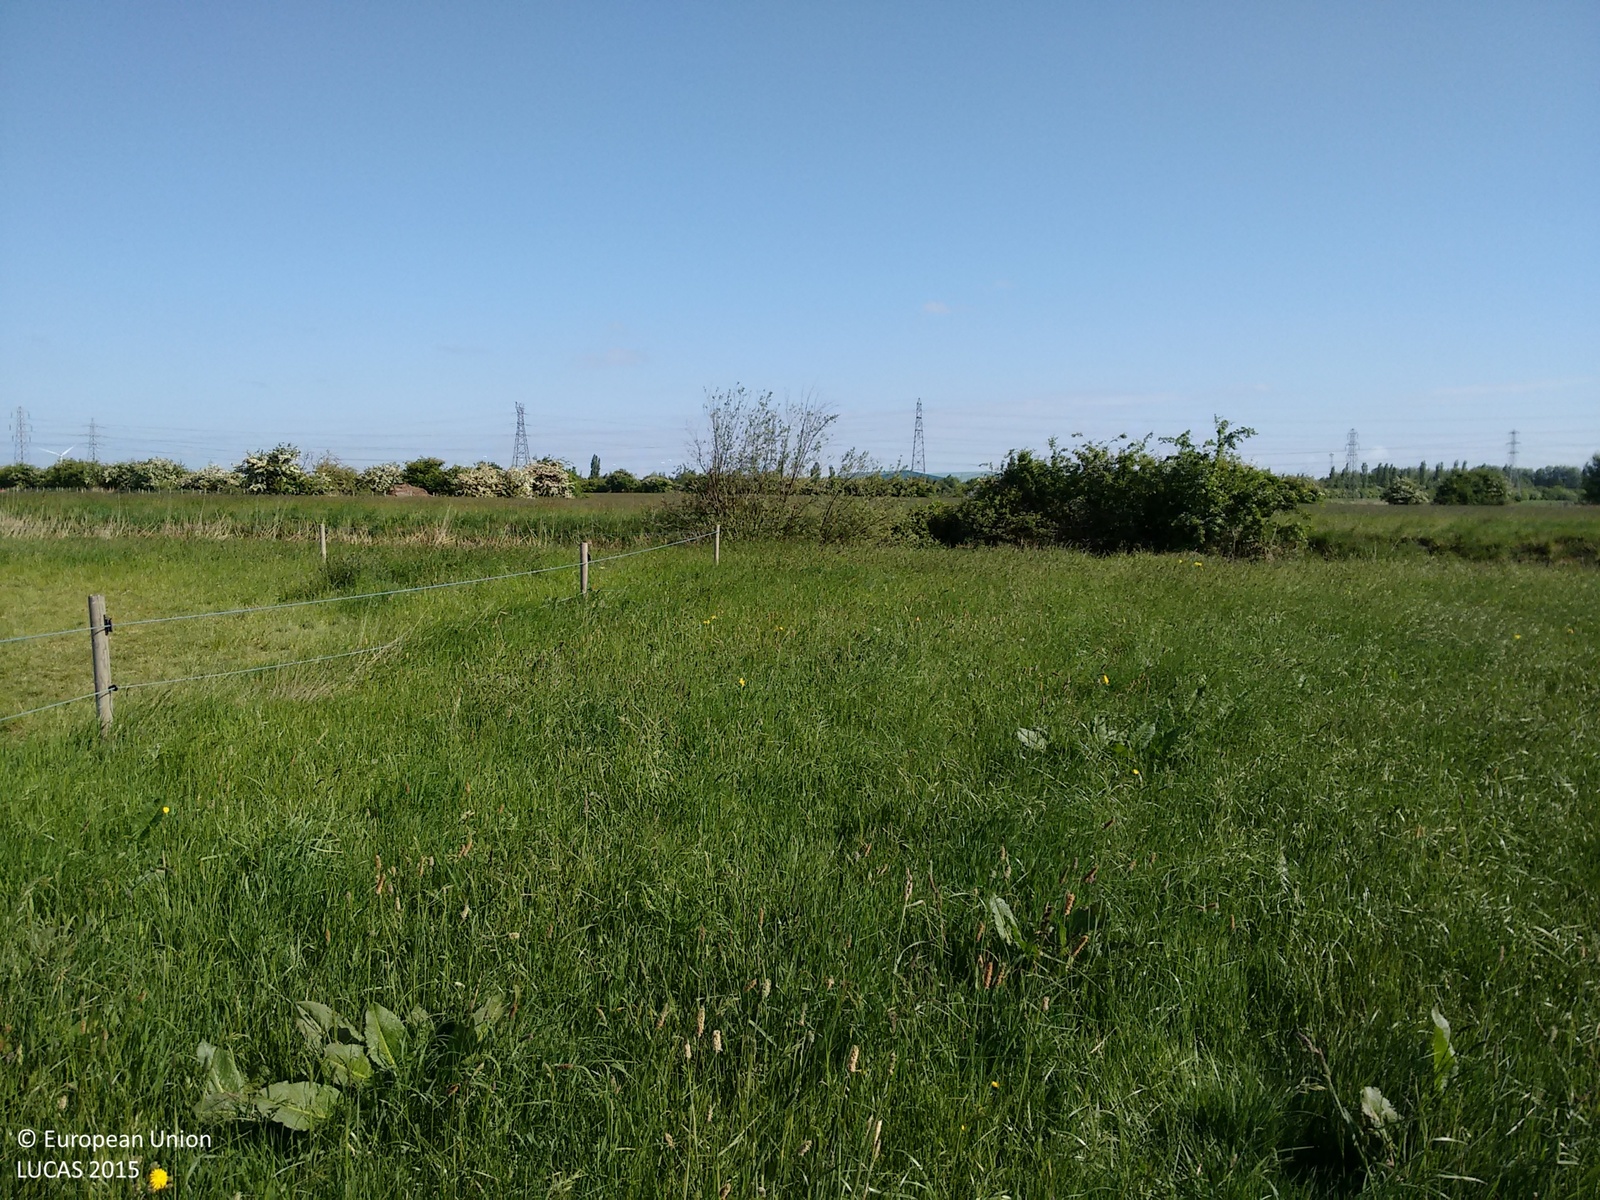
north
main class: Grassland
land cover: Grassland without tree/shrub cover
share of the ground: > 75 %
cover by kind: herbaceous plants 100 %
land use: Agriculture (excluding fallow land and kitchen gardens)
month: May
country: GB
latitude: 53.5957
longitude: -0.7222
